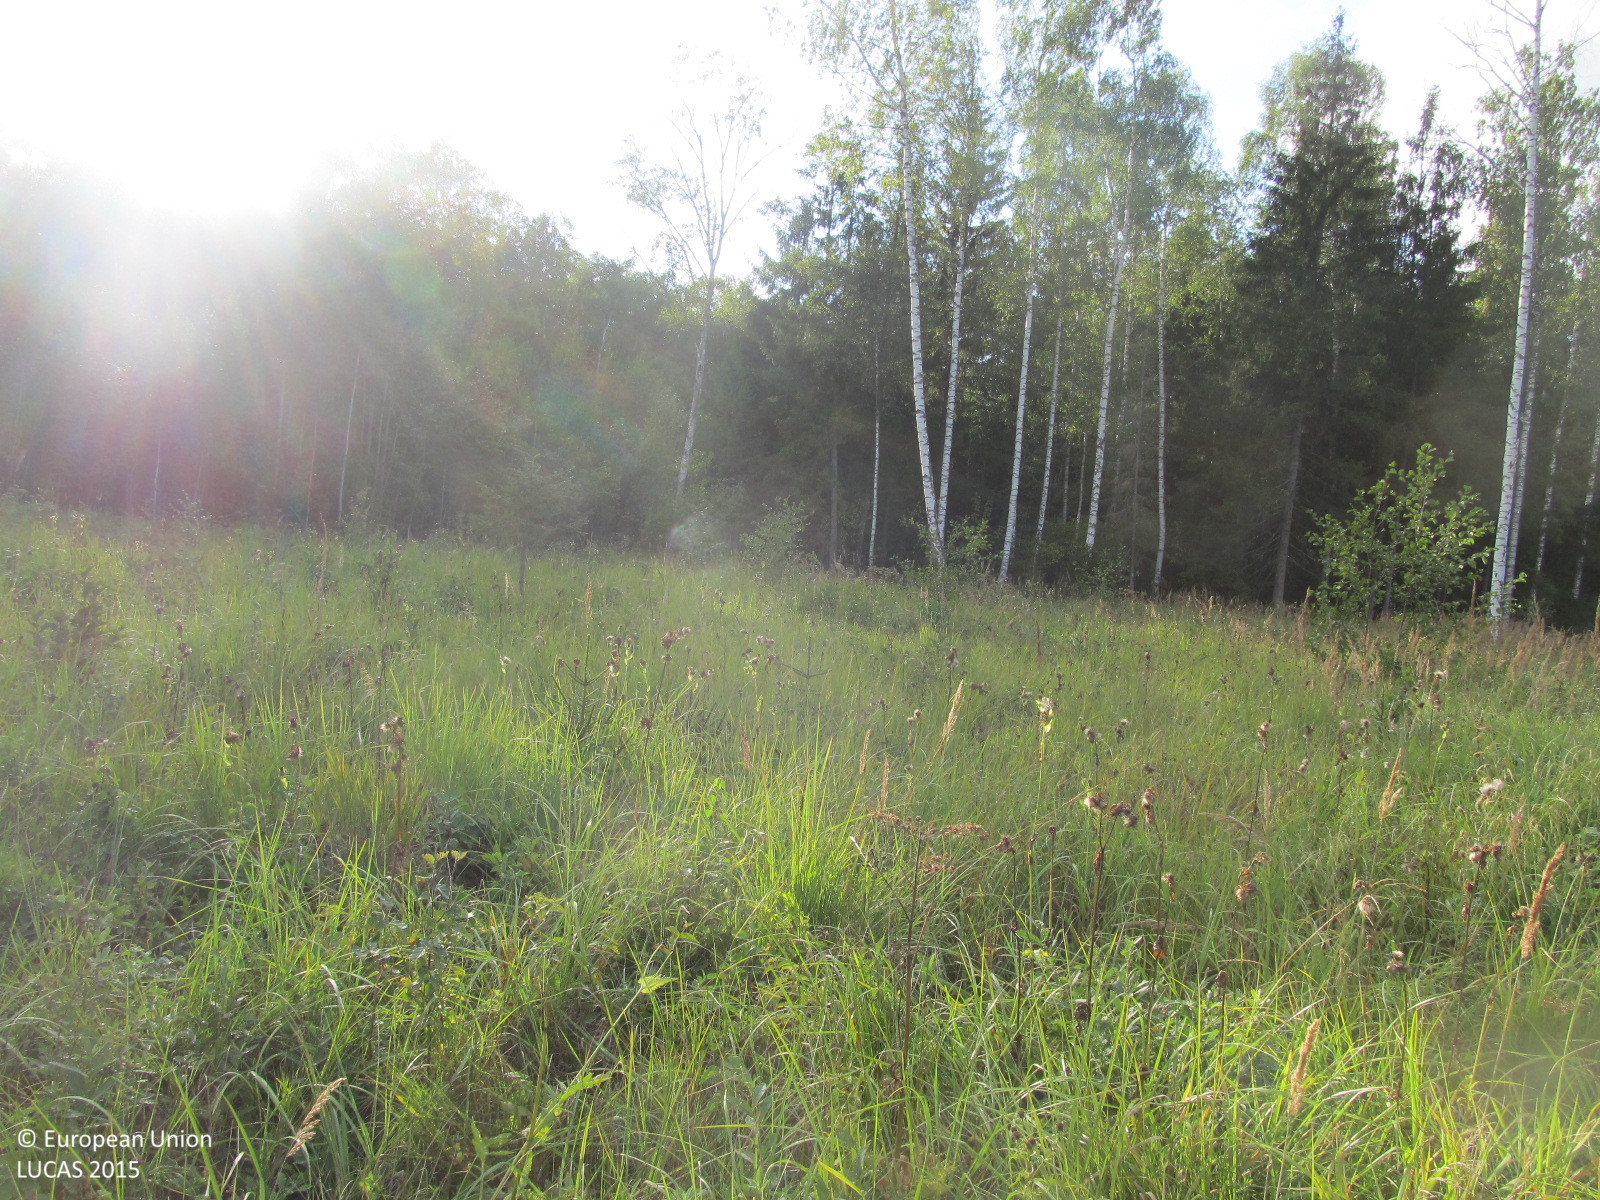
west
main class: Grassland
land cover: Spontaneously vegetated surfaces
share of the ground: > 75 %
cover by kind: herbaceous plants 95 %, shrubs 5 %
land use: Forestry
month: September
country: LT
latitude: 56.1606
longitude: 23.3576
